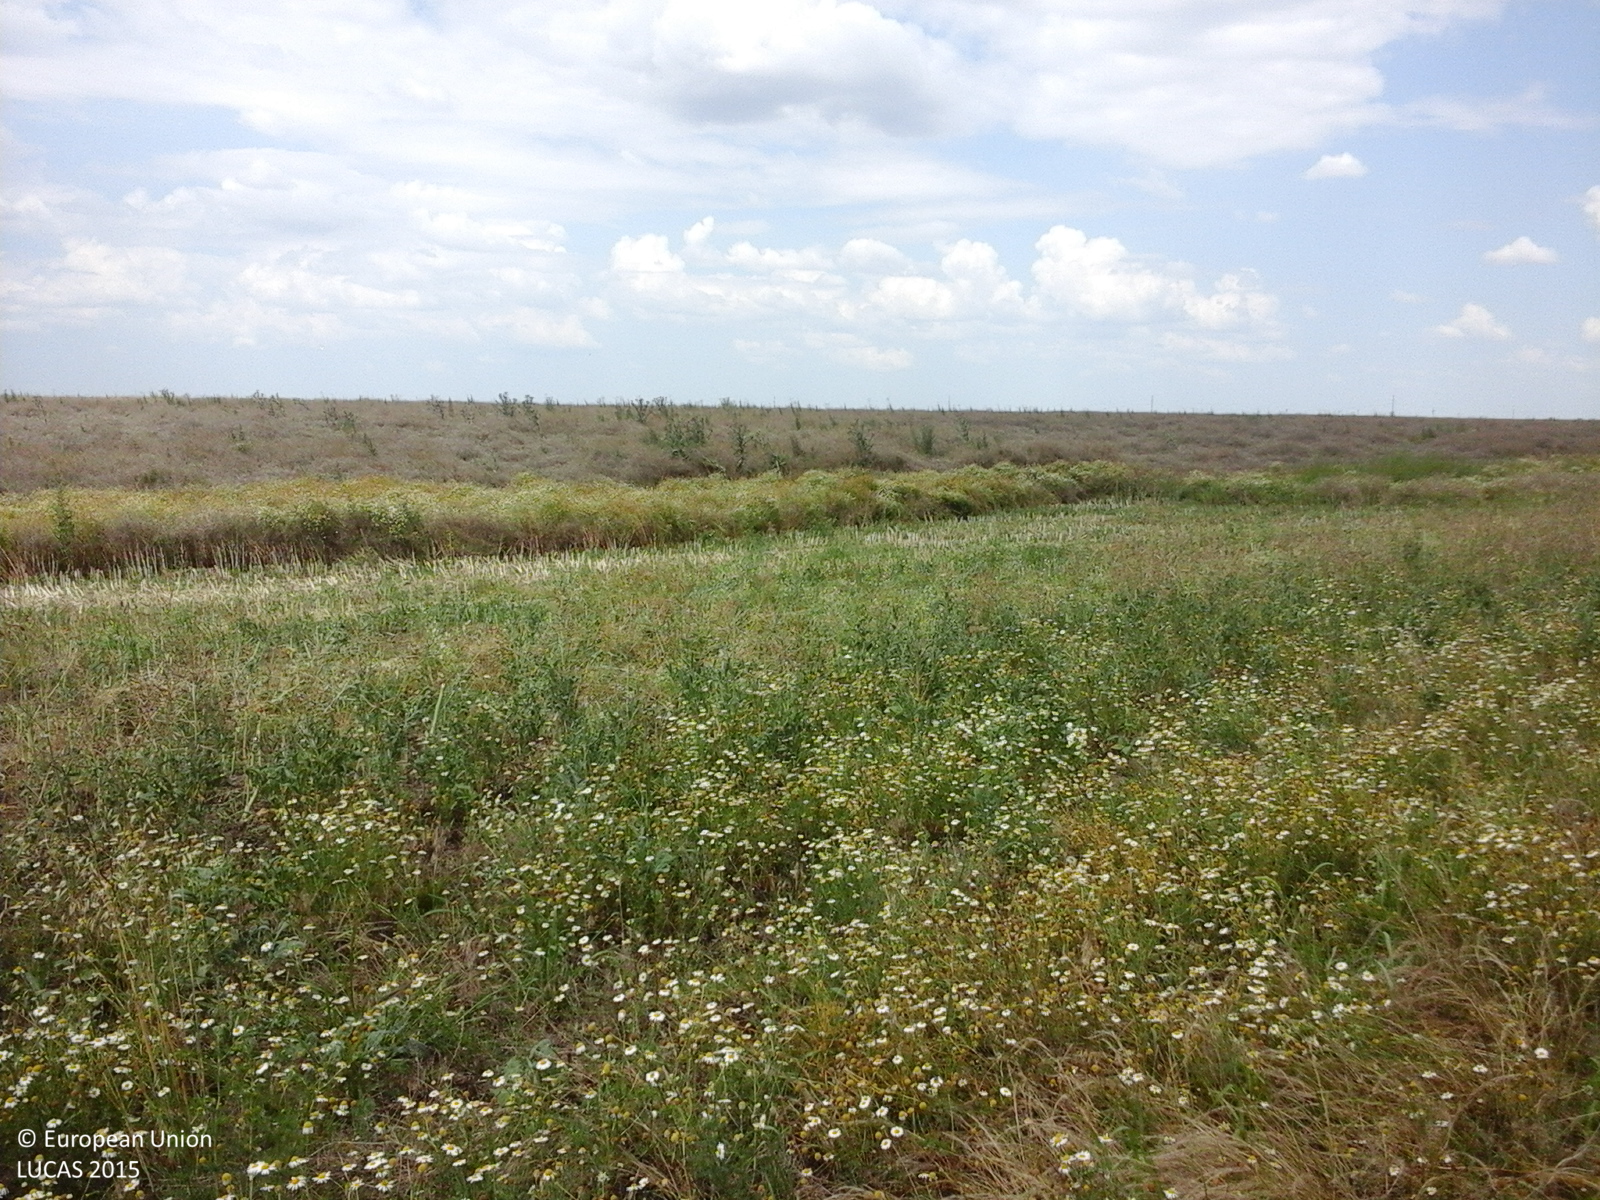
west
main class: Cropland
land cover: Maize
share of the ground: > 75 %
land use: Agriculture (excluding fallow land and kitchen gardens)
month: July
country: RO
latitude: 43.8966
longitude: 25.2308
